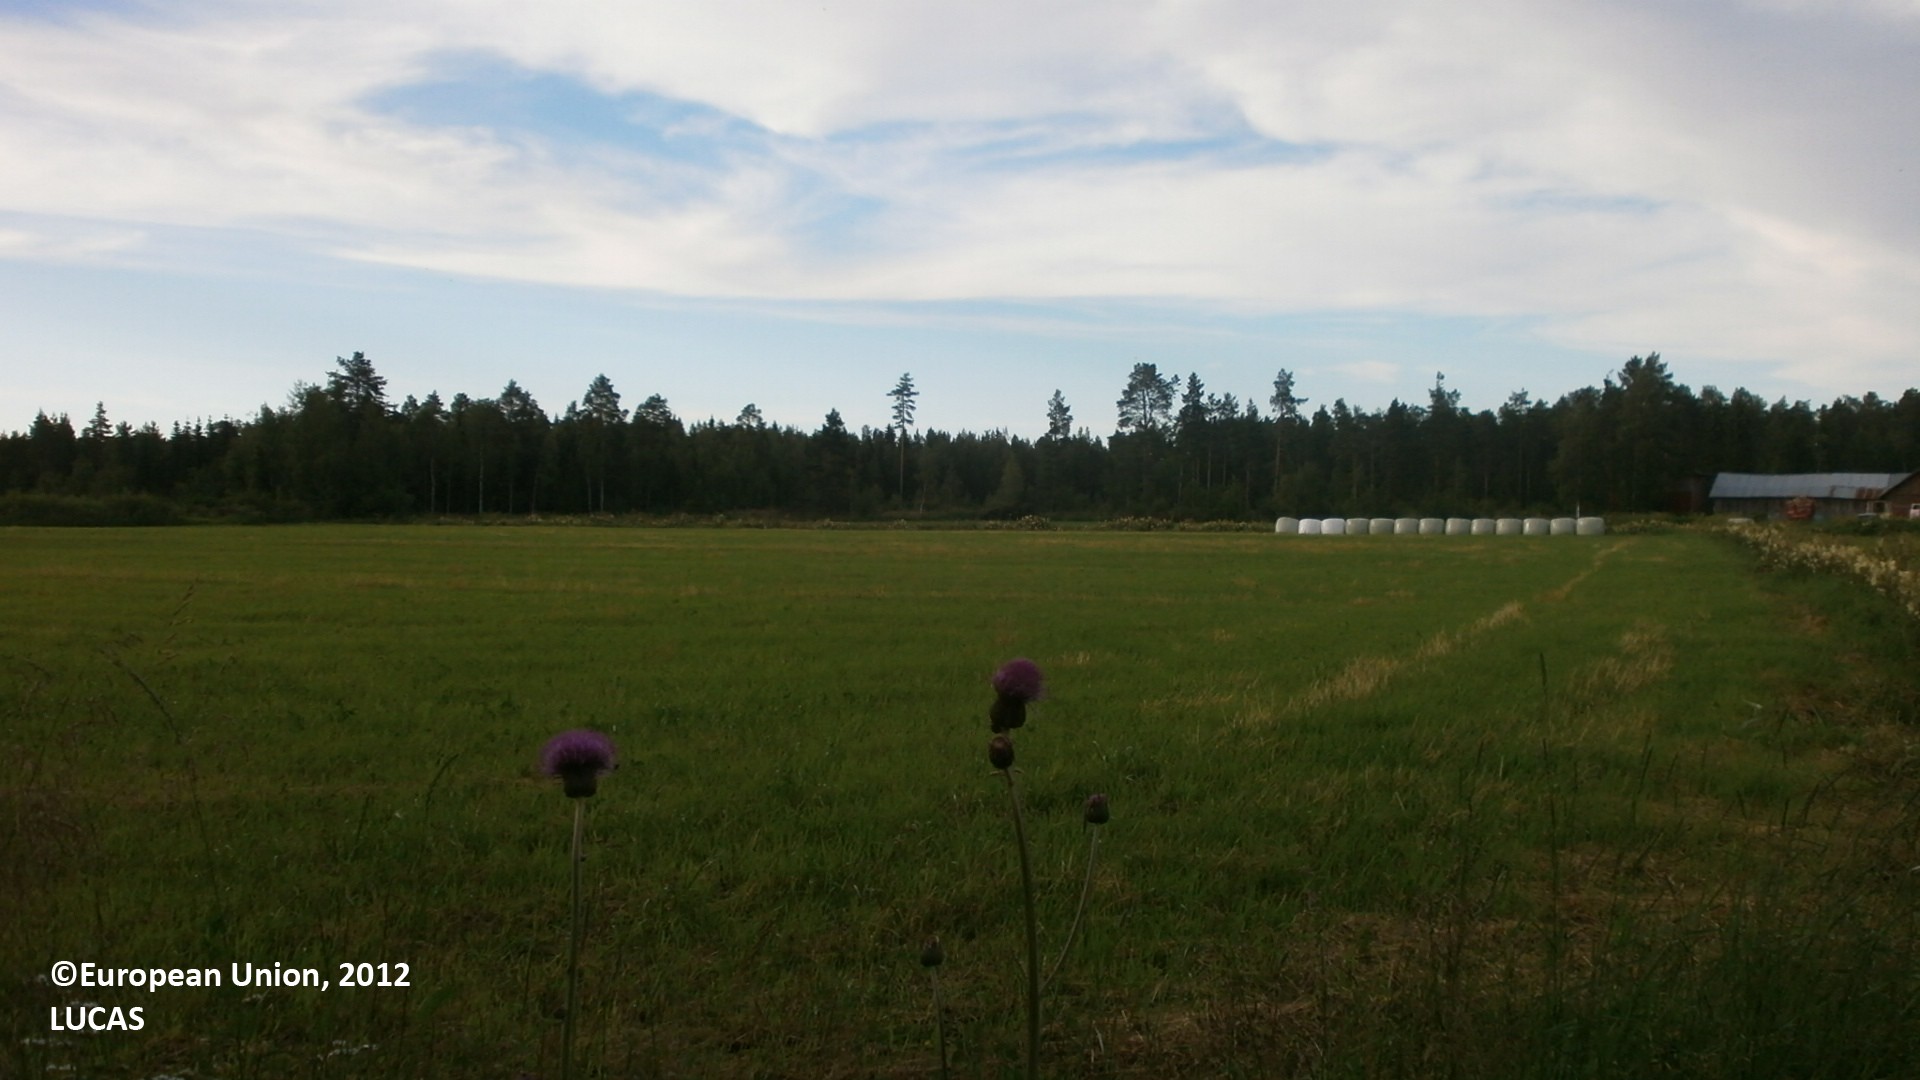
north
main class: Grassland
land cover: Grassland without tree/shrub cover
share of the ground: > 75 %
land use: Agriculture (excluding fallow land and kitchen gardens)
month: July
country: FI
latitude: 64.4535
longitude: 24.2178
